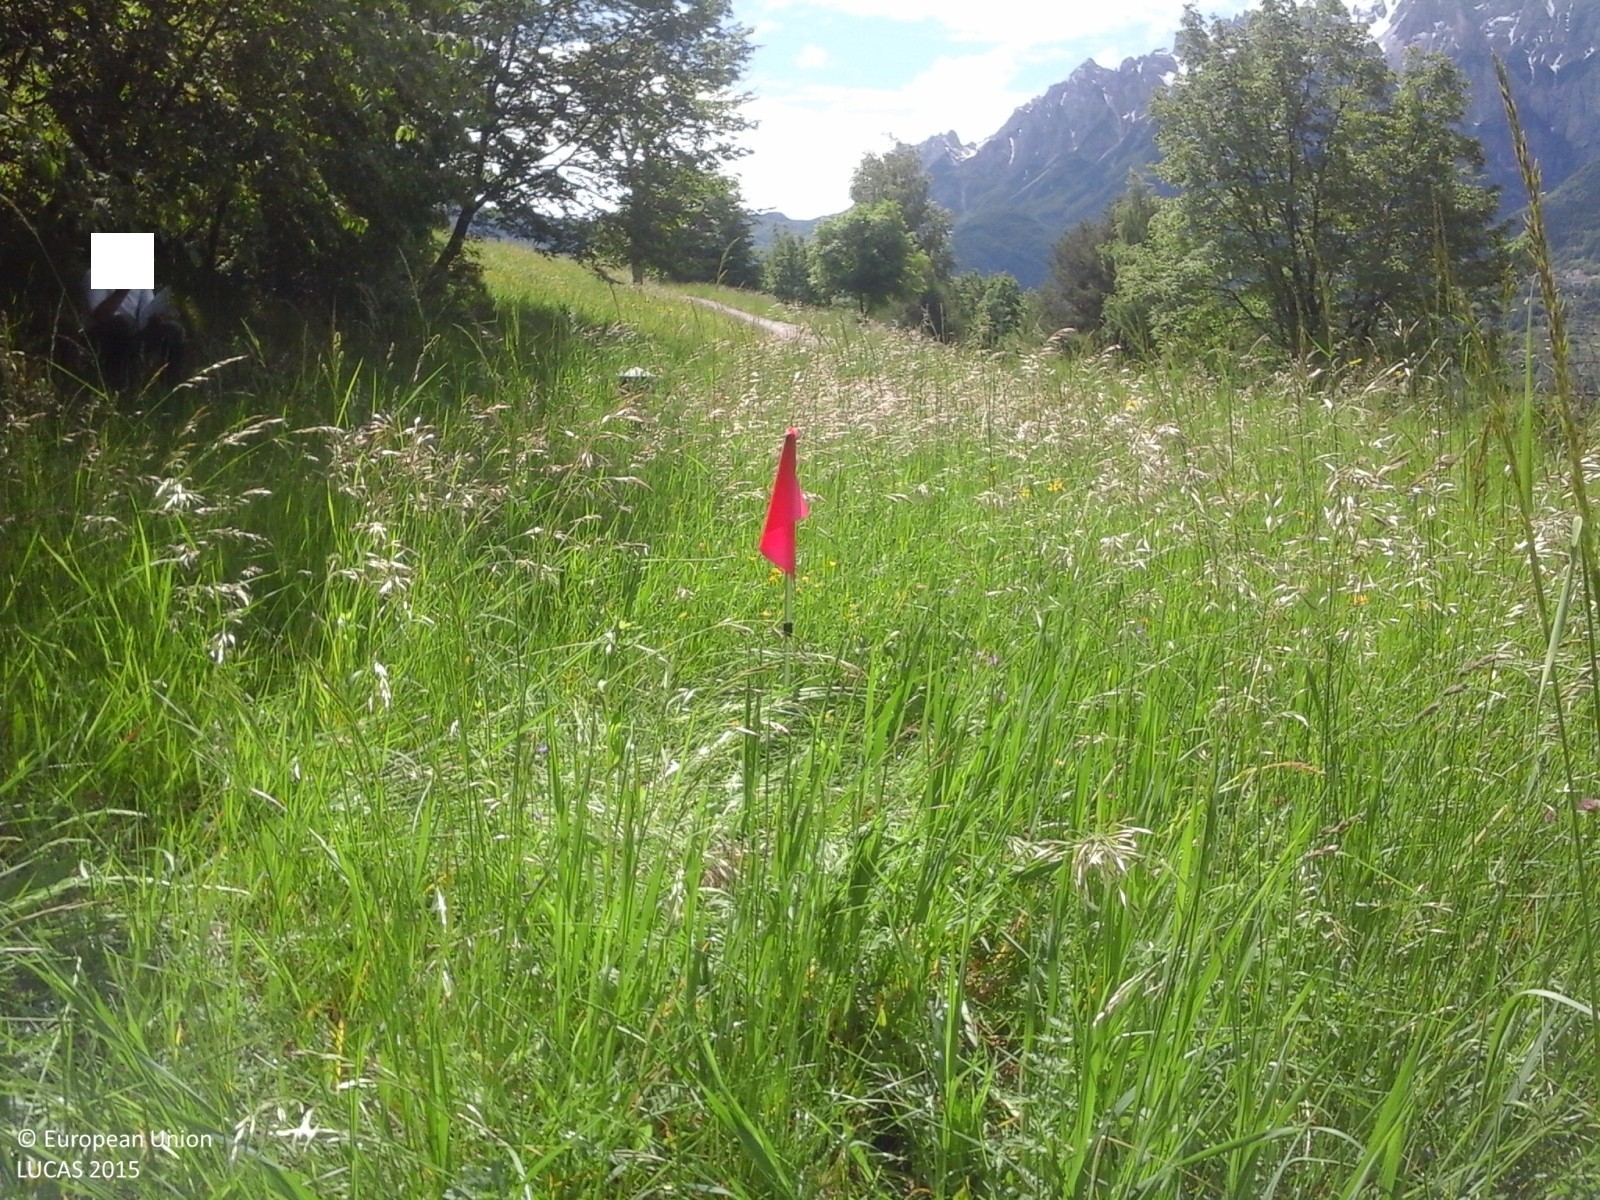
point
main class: Grassland
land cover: Grassland without tree/shrub cover
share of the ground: > 75 %
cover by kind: herbaceous plants 100 %
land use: Agriculture (excluding fallow land and kitchen gardens)
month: May
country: IT
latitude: 45.7868
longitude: 11.1174
